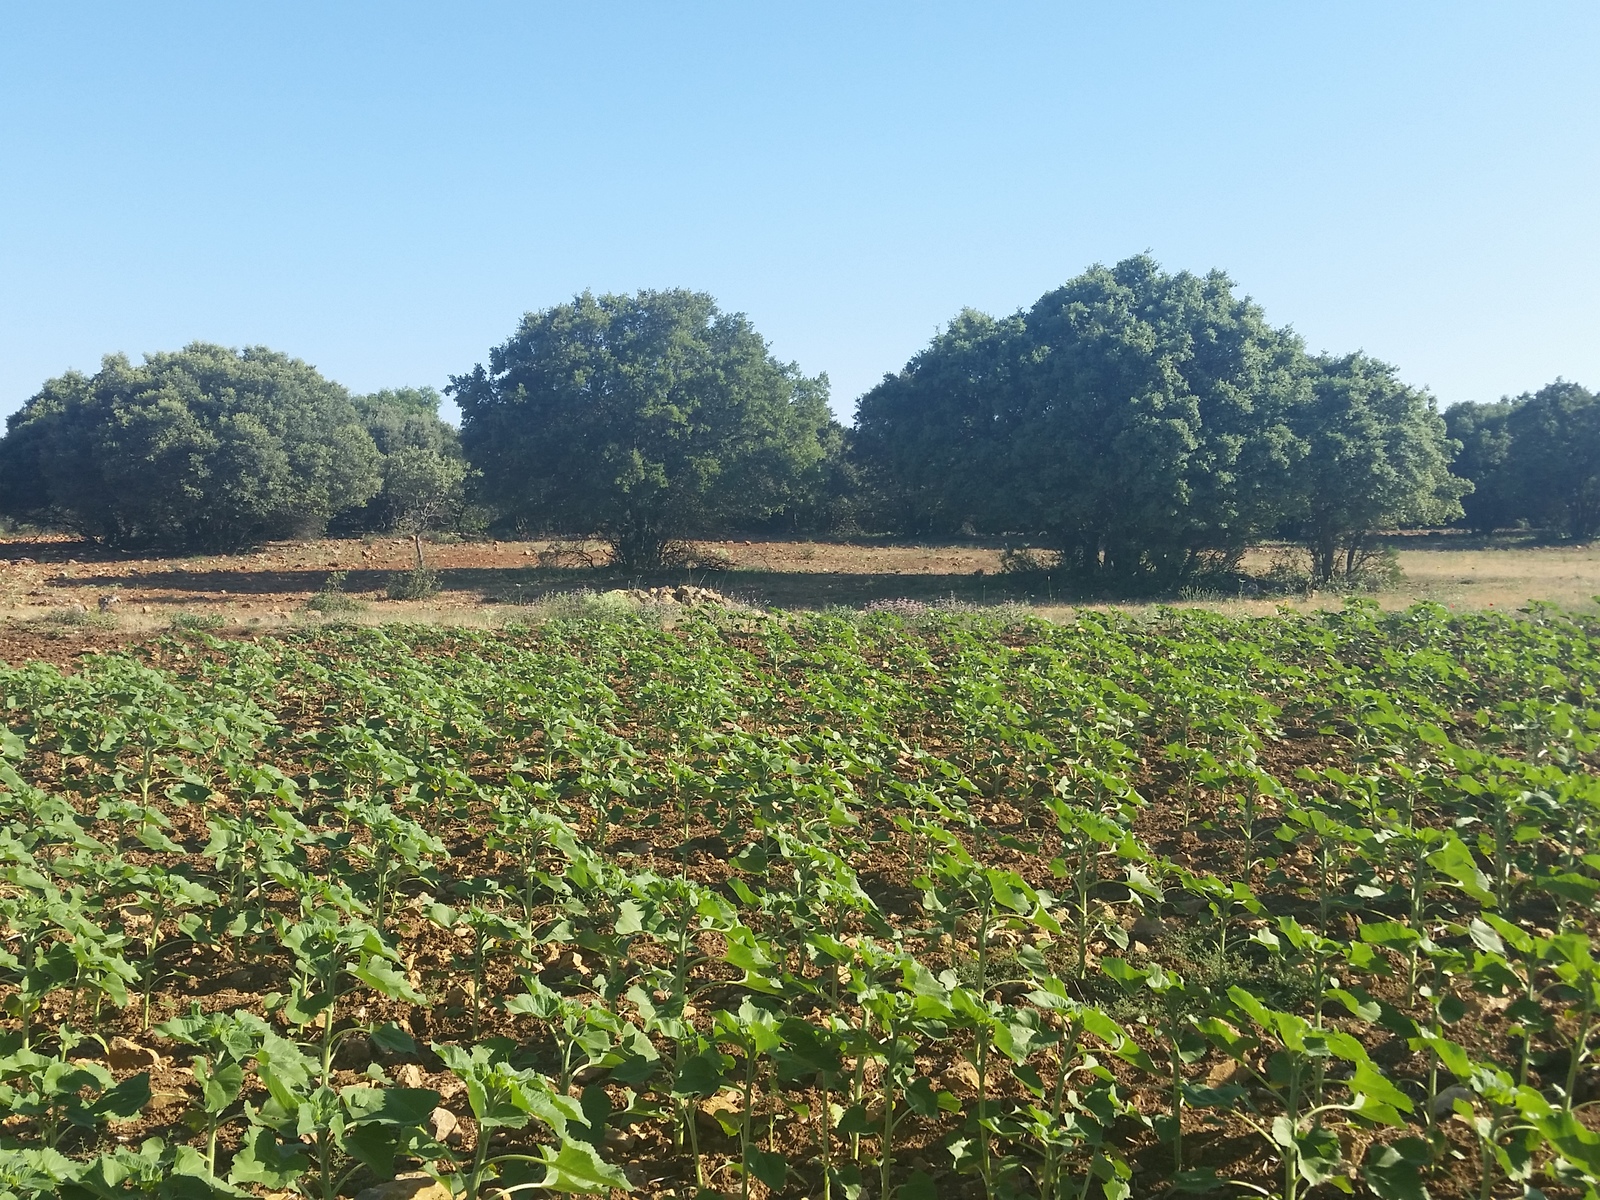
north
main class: Cropland
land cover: Sunflower
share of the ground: > 75 %
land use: Agriculture (excluding fallow land and kitchen gardens)
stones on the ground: 10 - 25 %
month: June
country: ES
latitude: 38.7348
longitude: -2.4837
